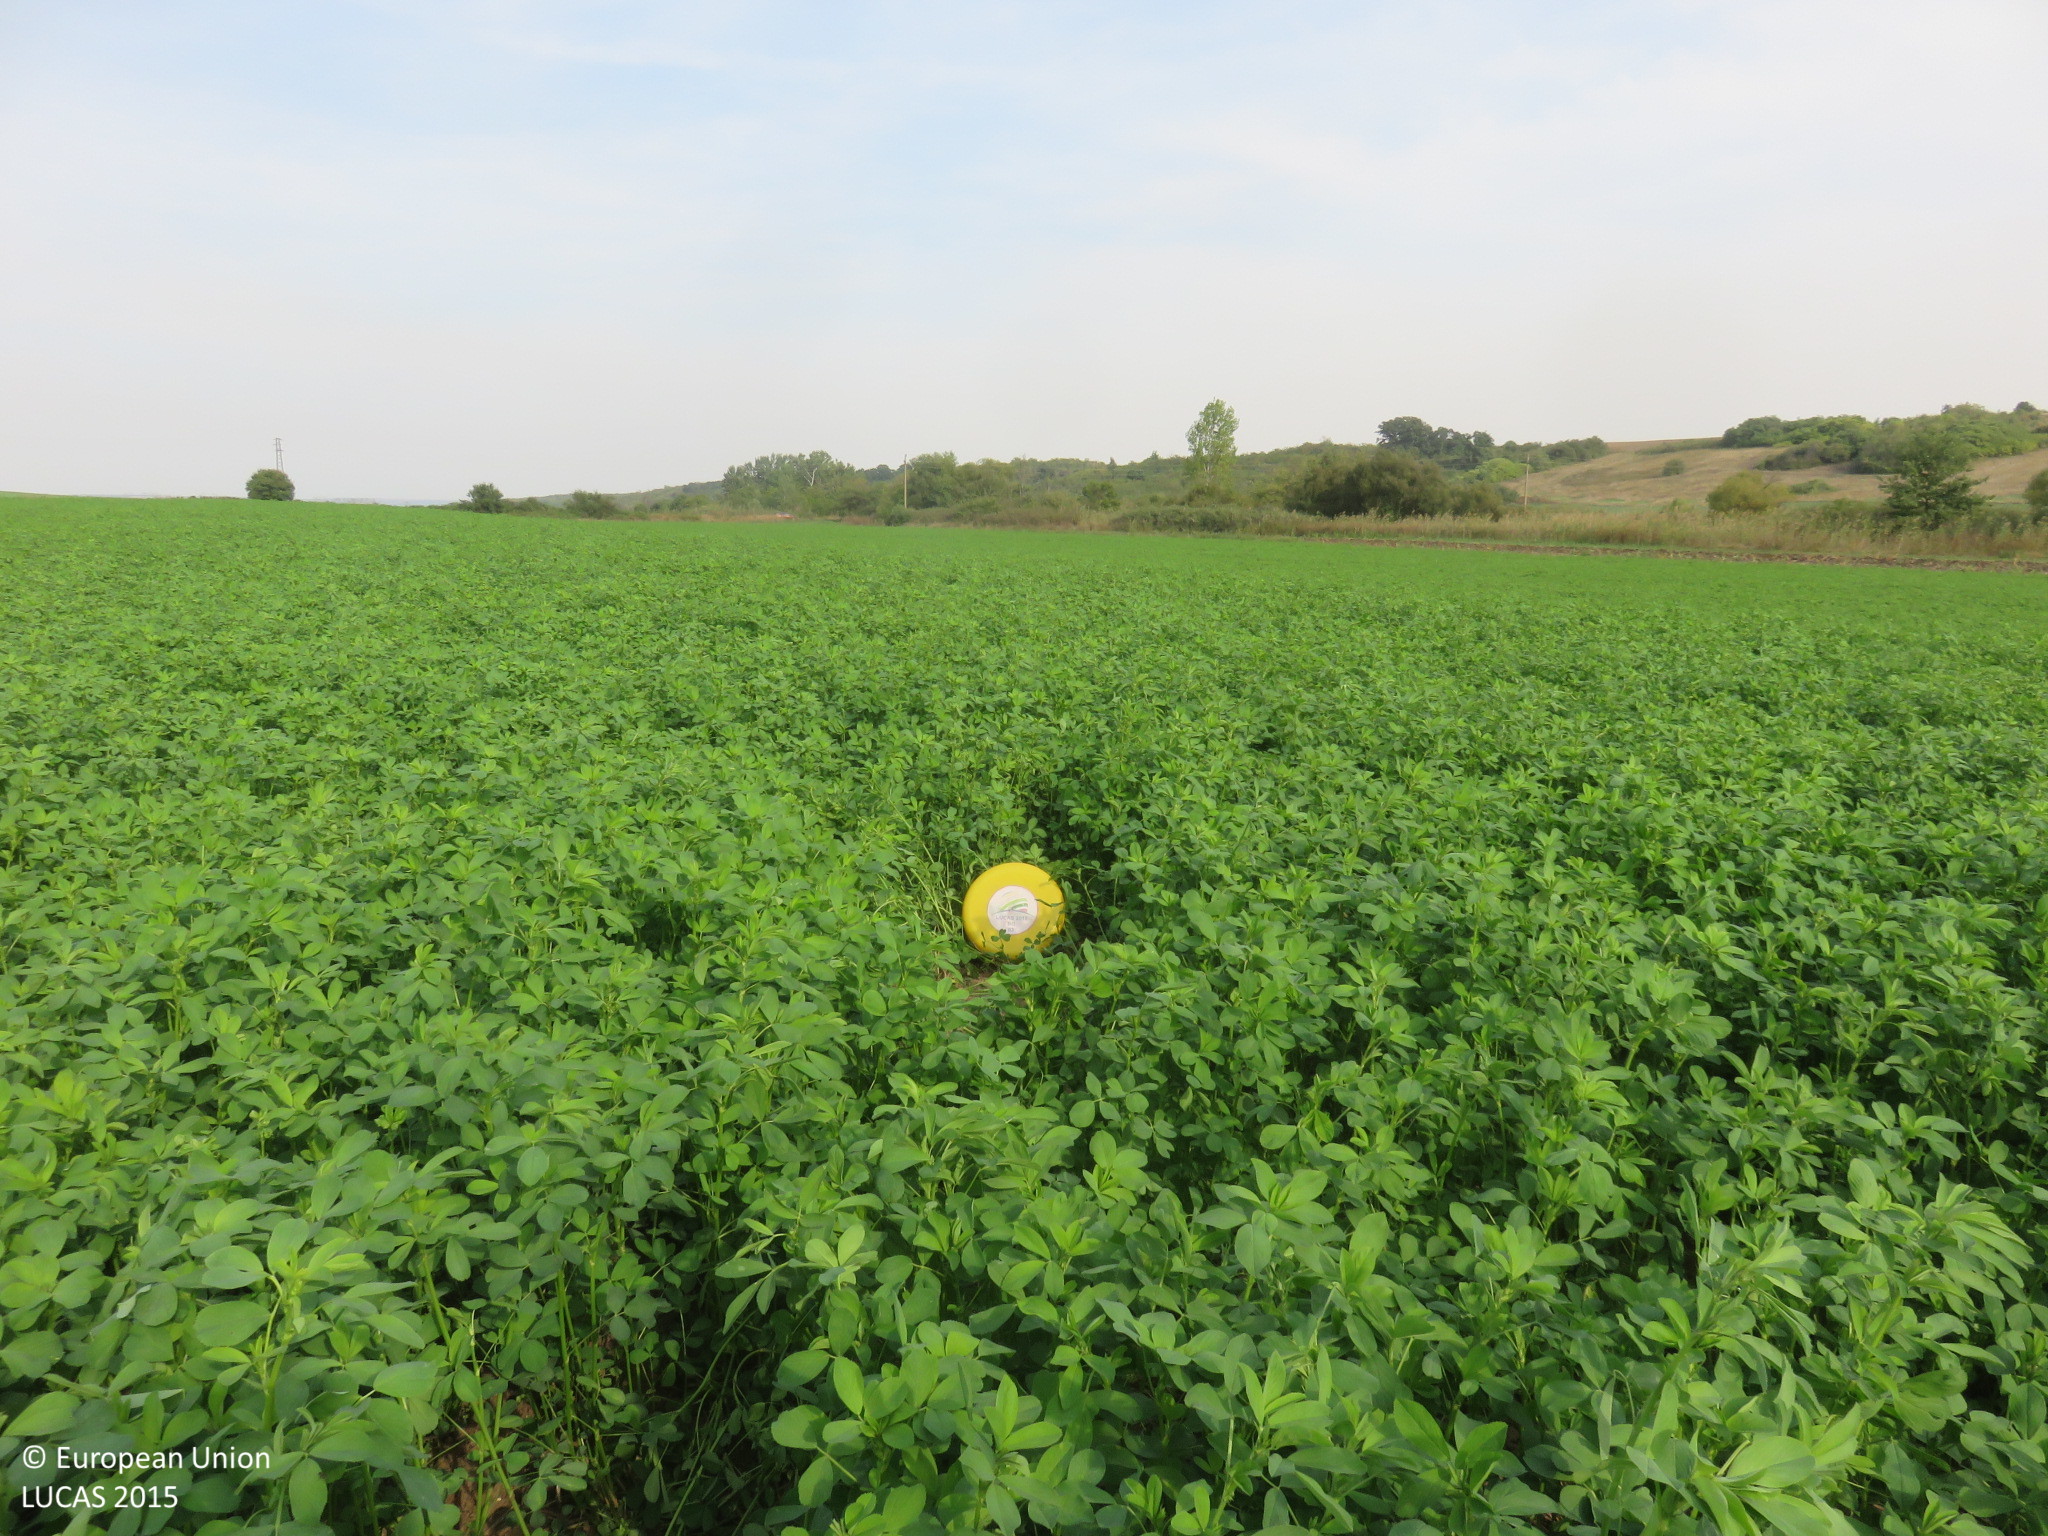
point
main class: Cropland
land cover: Lucerne
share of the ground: > 75 %
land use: Agriculture (excluding fallow land and kitchen gardens)
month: September
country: BG
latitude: 43.4106
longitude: 24.9250
